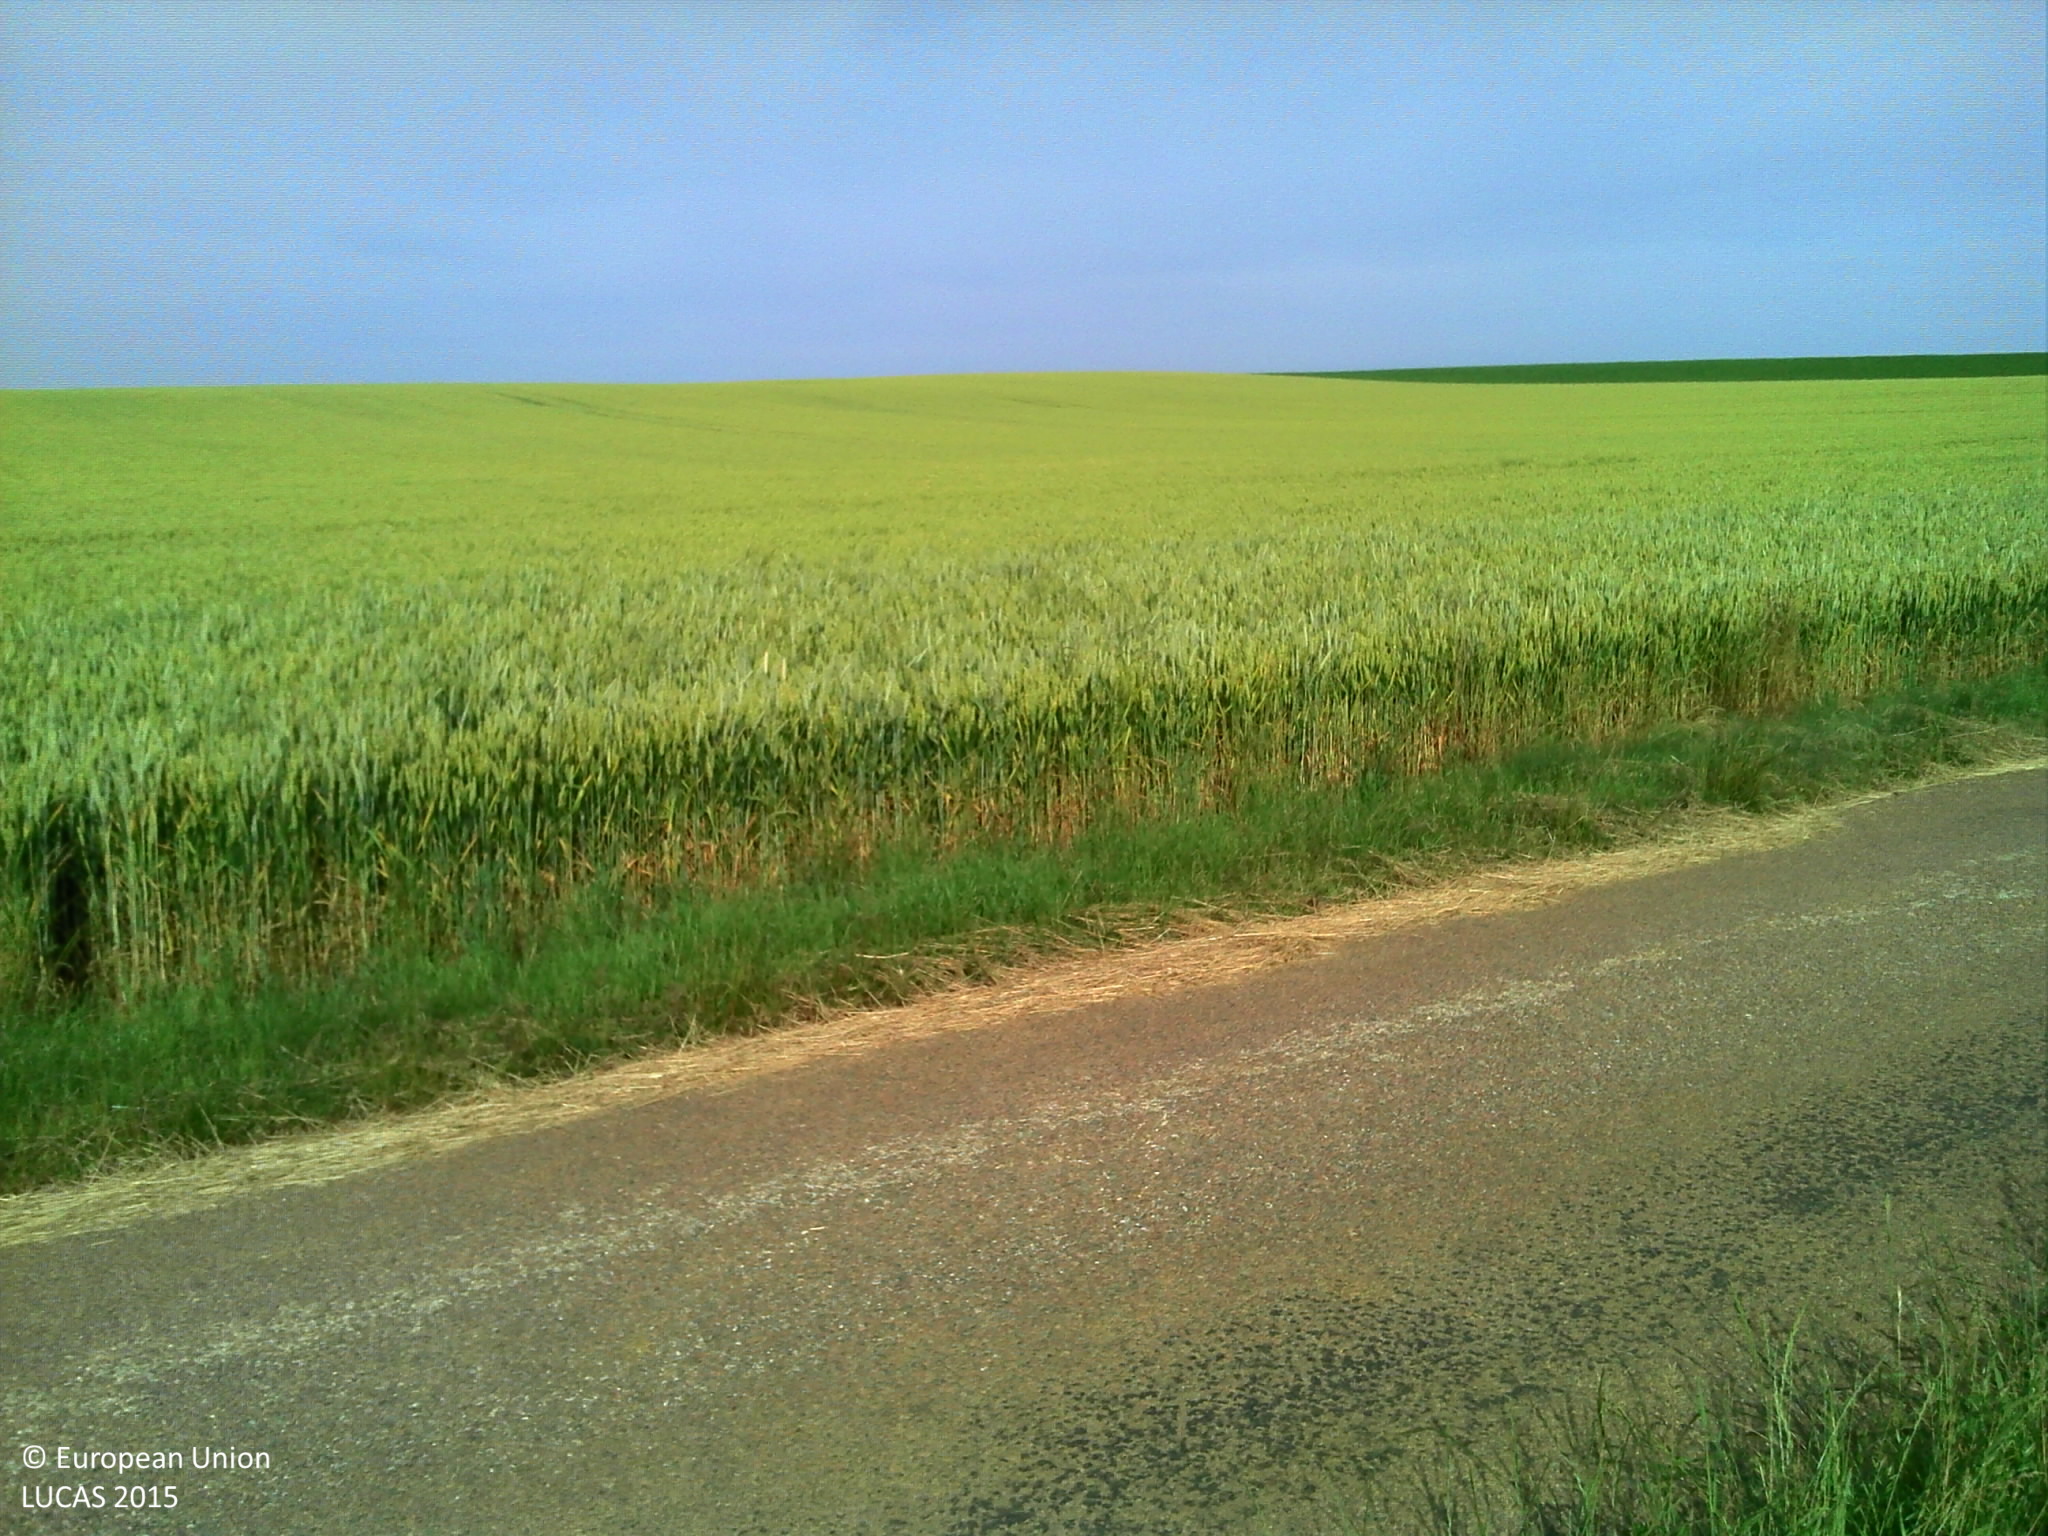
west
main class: Cropland
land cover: Rape and turnip rape
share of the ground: 50 - 75 %
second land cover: Spontaneously vegetated surfaces
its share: 25 - 50 %
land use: Agriculture (excluding fallow land and kitchen gardens)
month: June
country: FR
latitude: 48.5680
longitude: 5.1606
